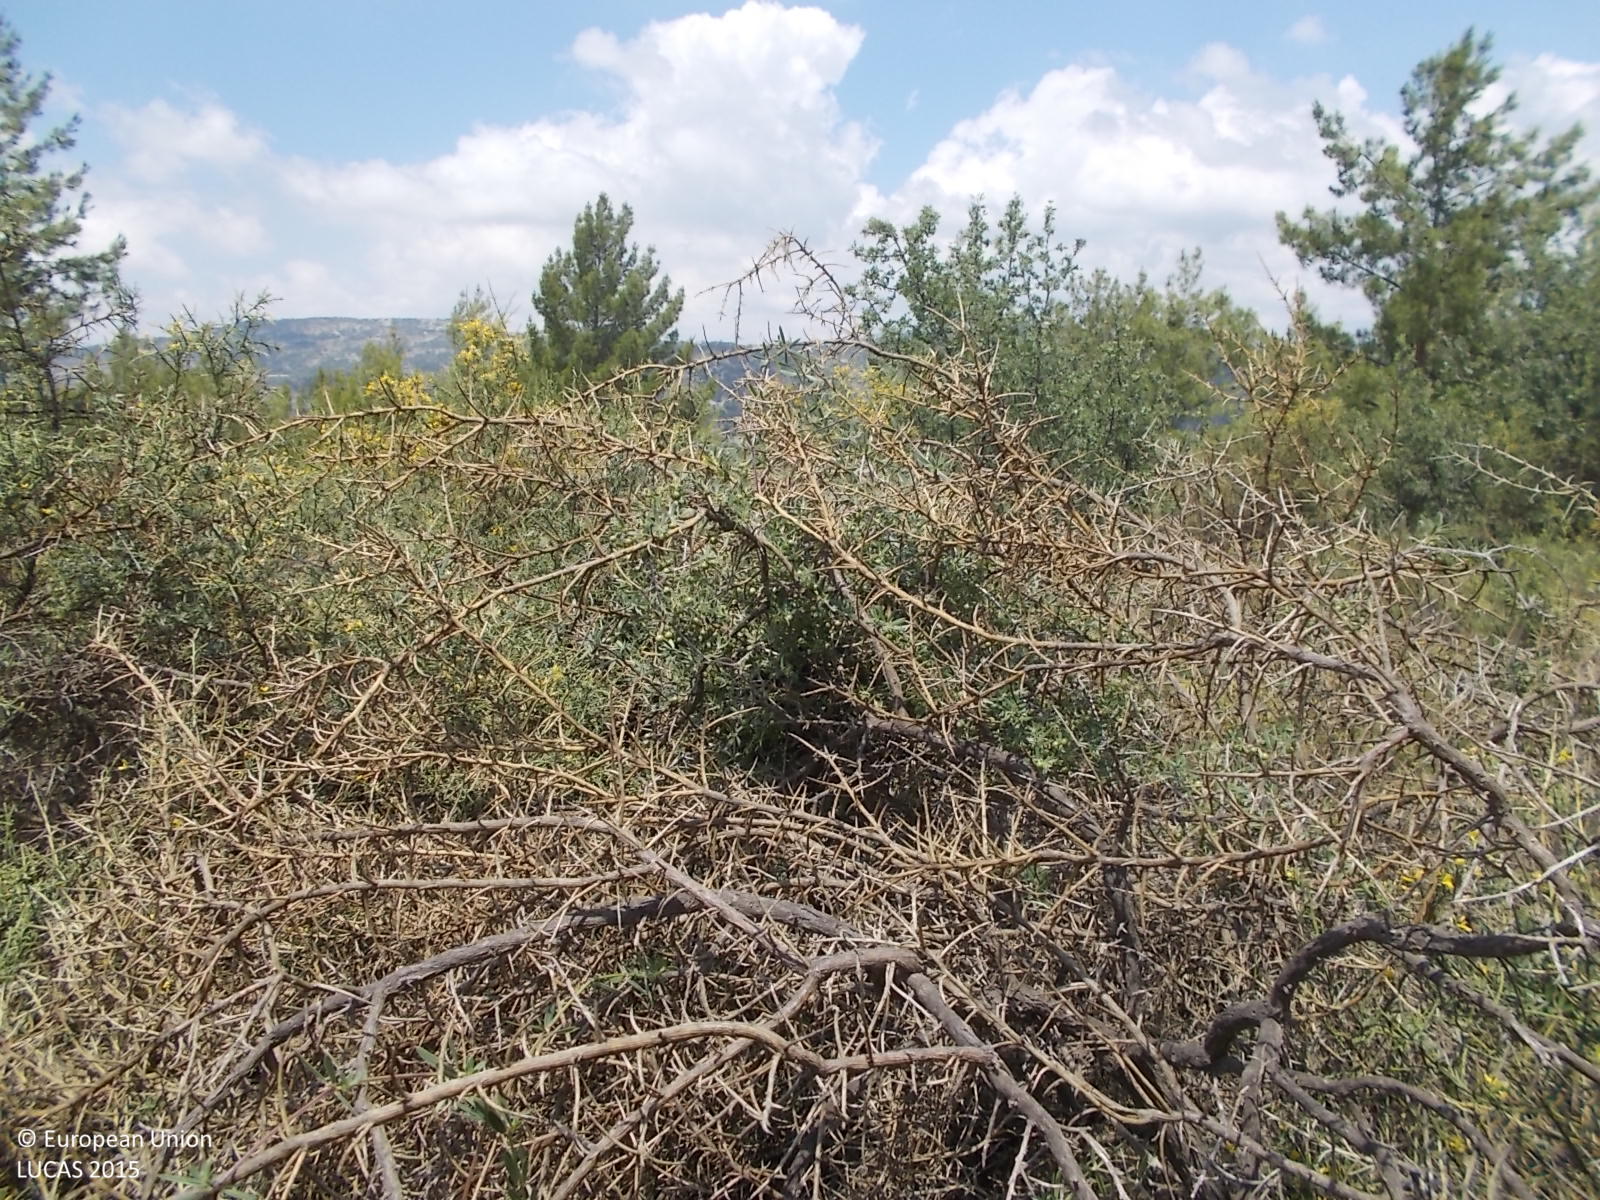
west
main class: Shrubland
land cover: Shrubland with sparse tree cover
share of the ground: > 75 %
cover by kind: shrubs 85 %, unconsolidated bare surface 10 %, broadleaved forest trees 5 %
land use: Semi-natural and natural areas not in use
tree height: > 5 m
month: June
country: CY
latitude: 34.8758
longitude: 32.7518
